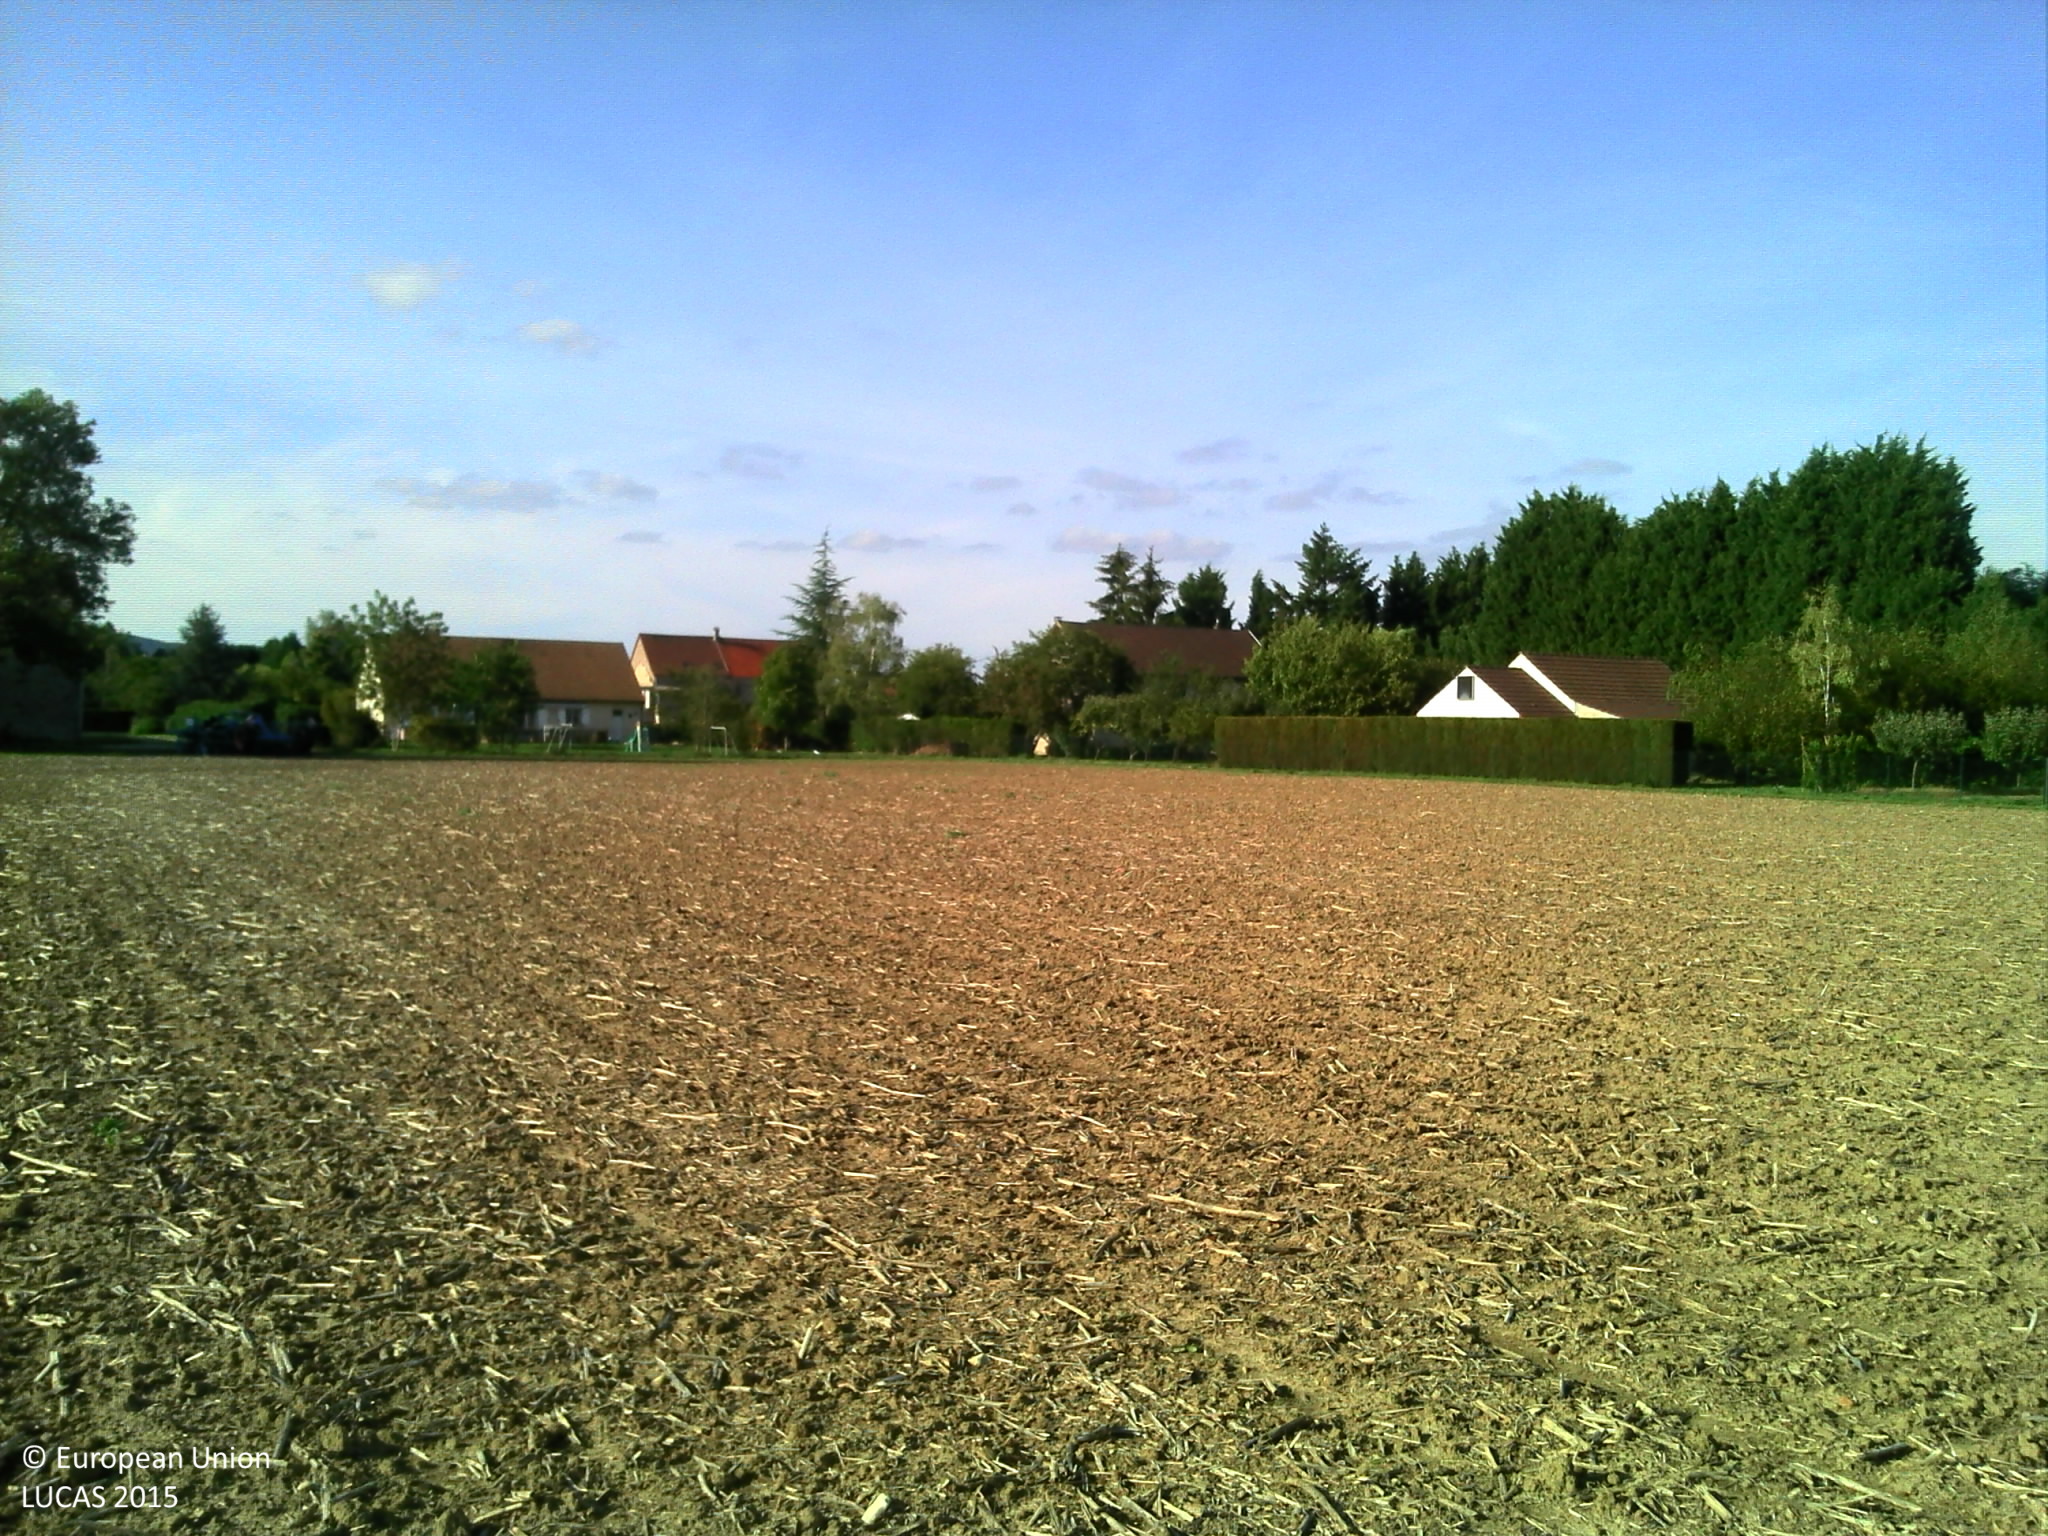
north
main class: Cropland
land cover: Rape and turnip rape
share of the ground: < 10 %
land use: Agriculture (excluding fallow land and kitchen gardens)
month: September
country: FR
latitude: 46.9279
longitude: 4.7869
